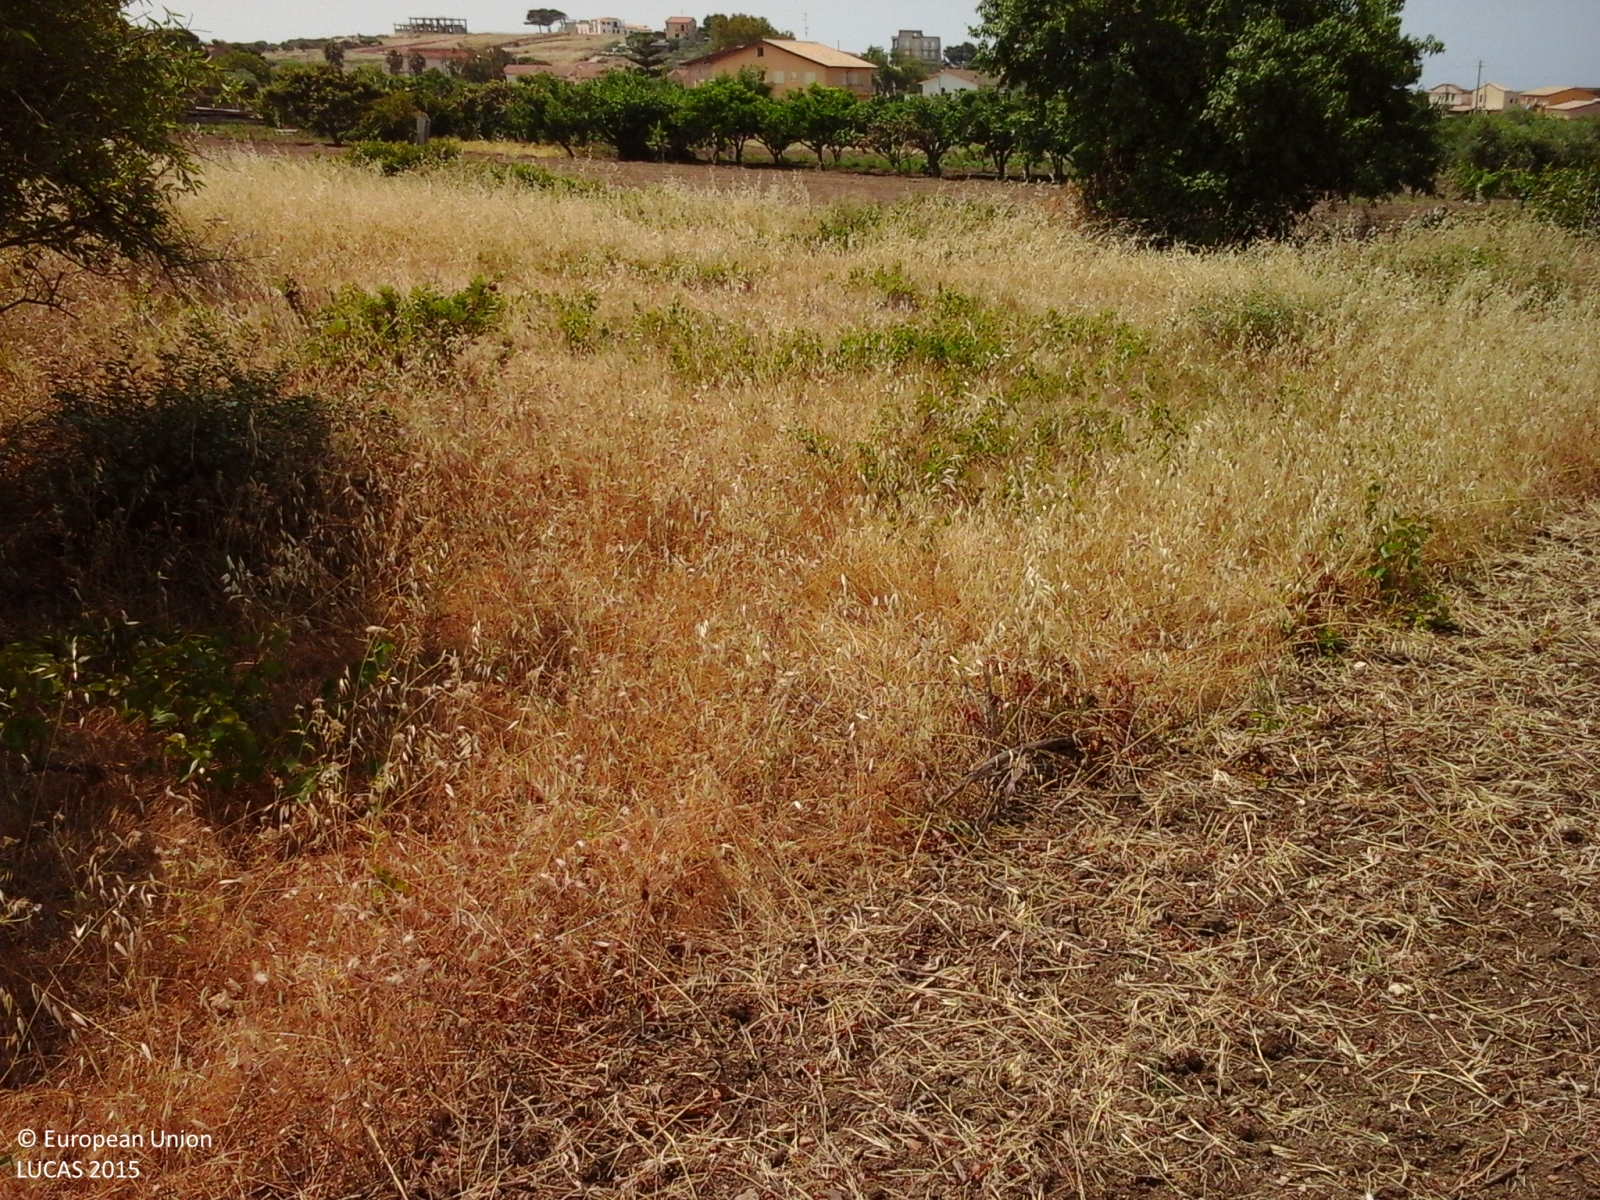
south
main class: Cropland
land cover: Other fruit trees and berries
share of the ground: 25 - 50 %
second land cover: Spontaneously vegetated surfaces
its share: > 75 %
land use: Kitchen garden
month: June
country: IT
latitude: 37.3030
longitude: 13.4590
